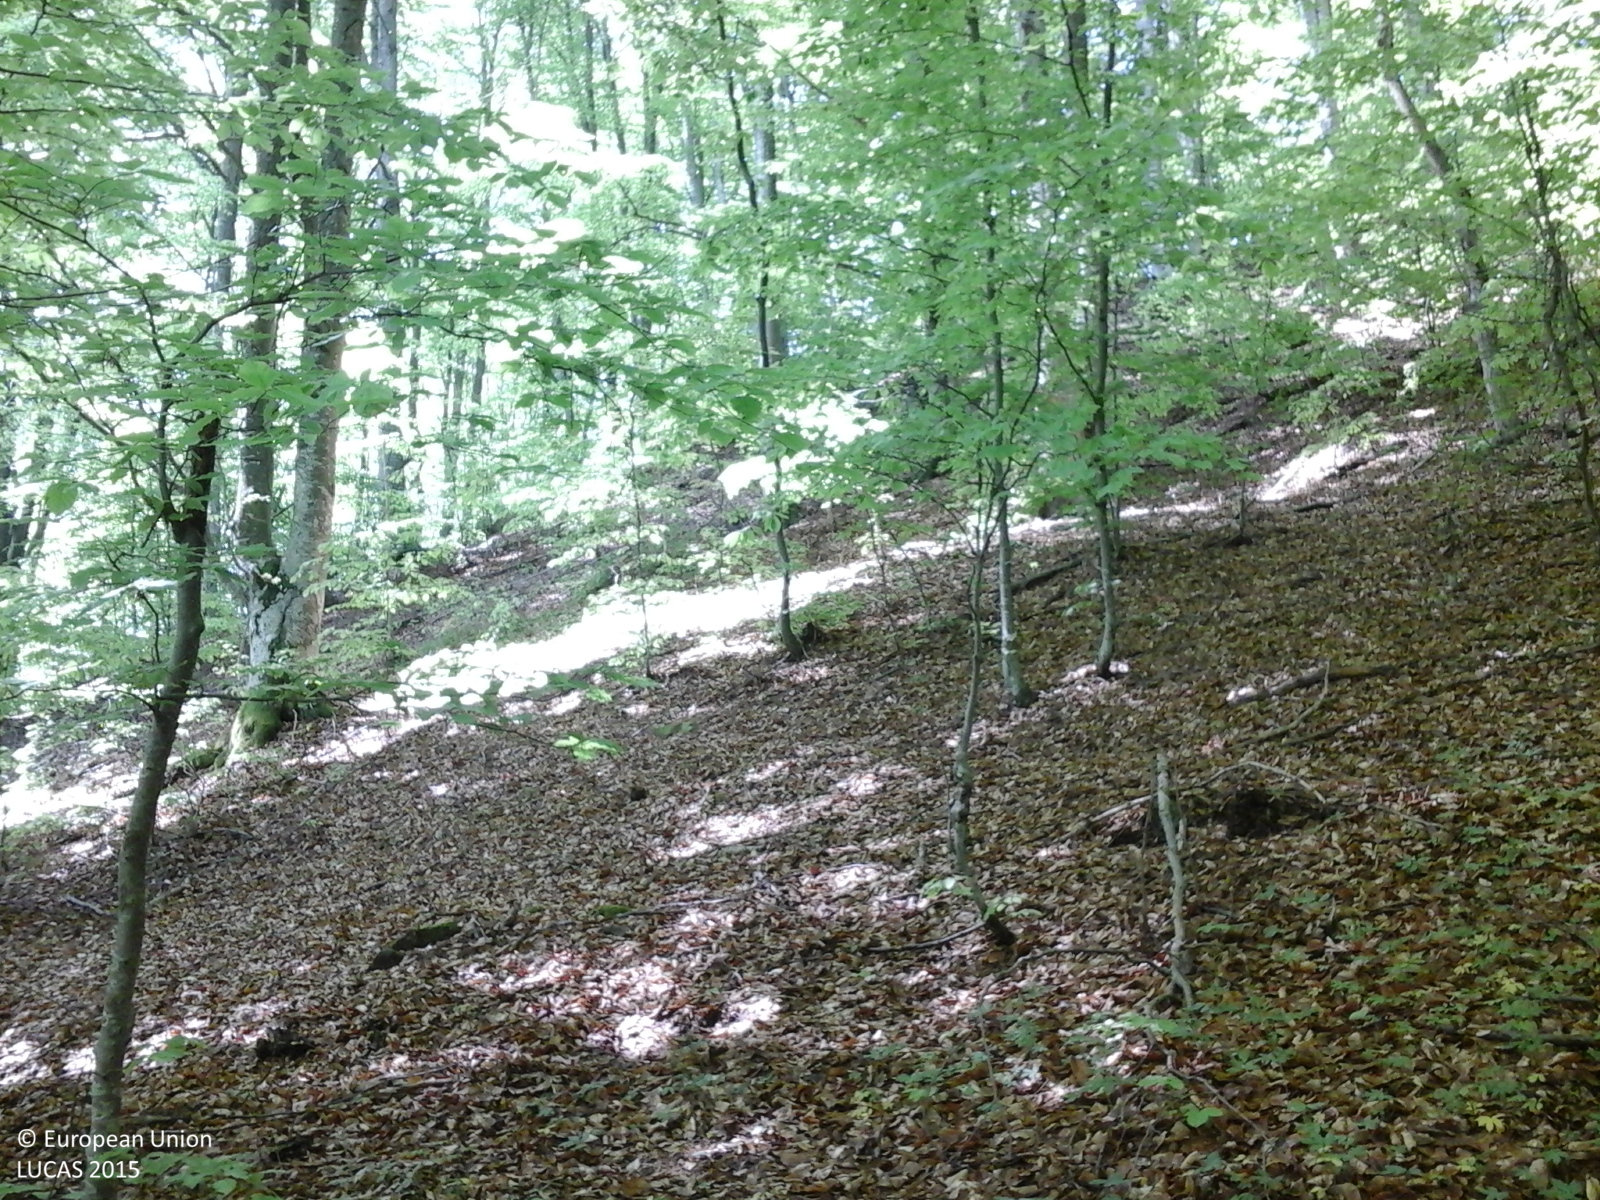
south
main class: Woodland
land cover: Broadleaved woodland
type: beech forest
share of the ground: > 75 %
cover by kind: broadleaved forest trees 100 %
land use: Forestry
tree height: > 5 m
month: May
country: RO
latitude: 45.7052
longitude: 26.0032
